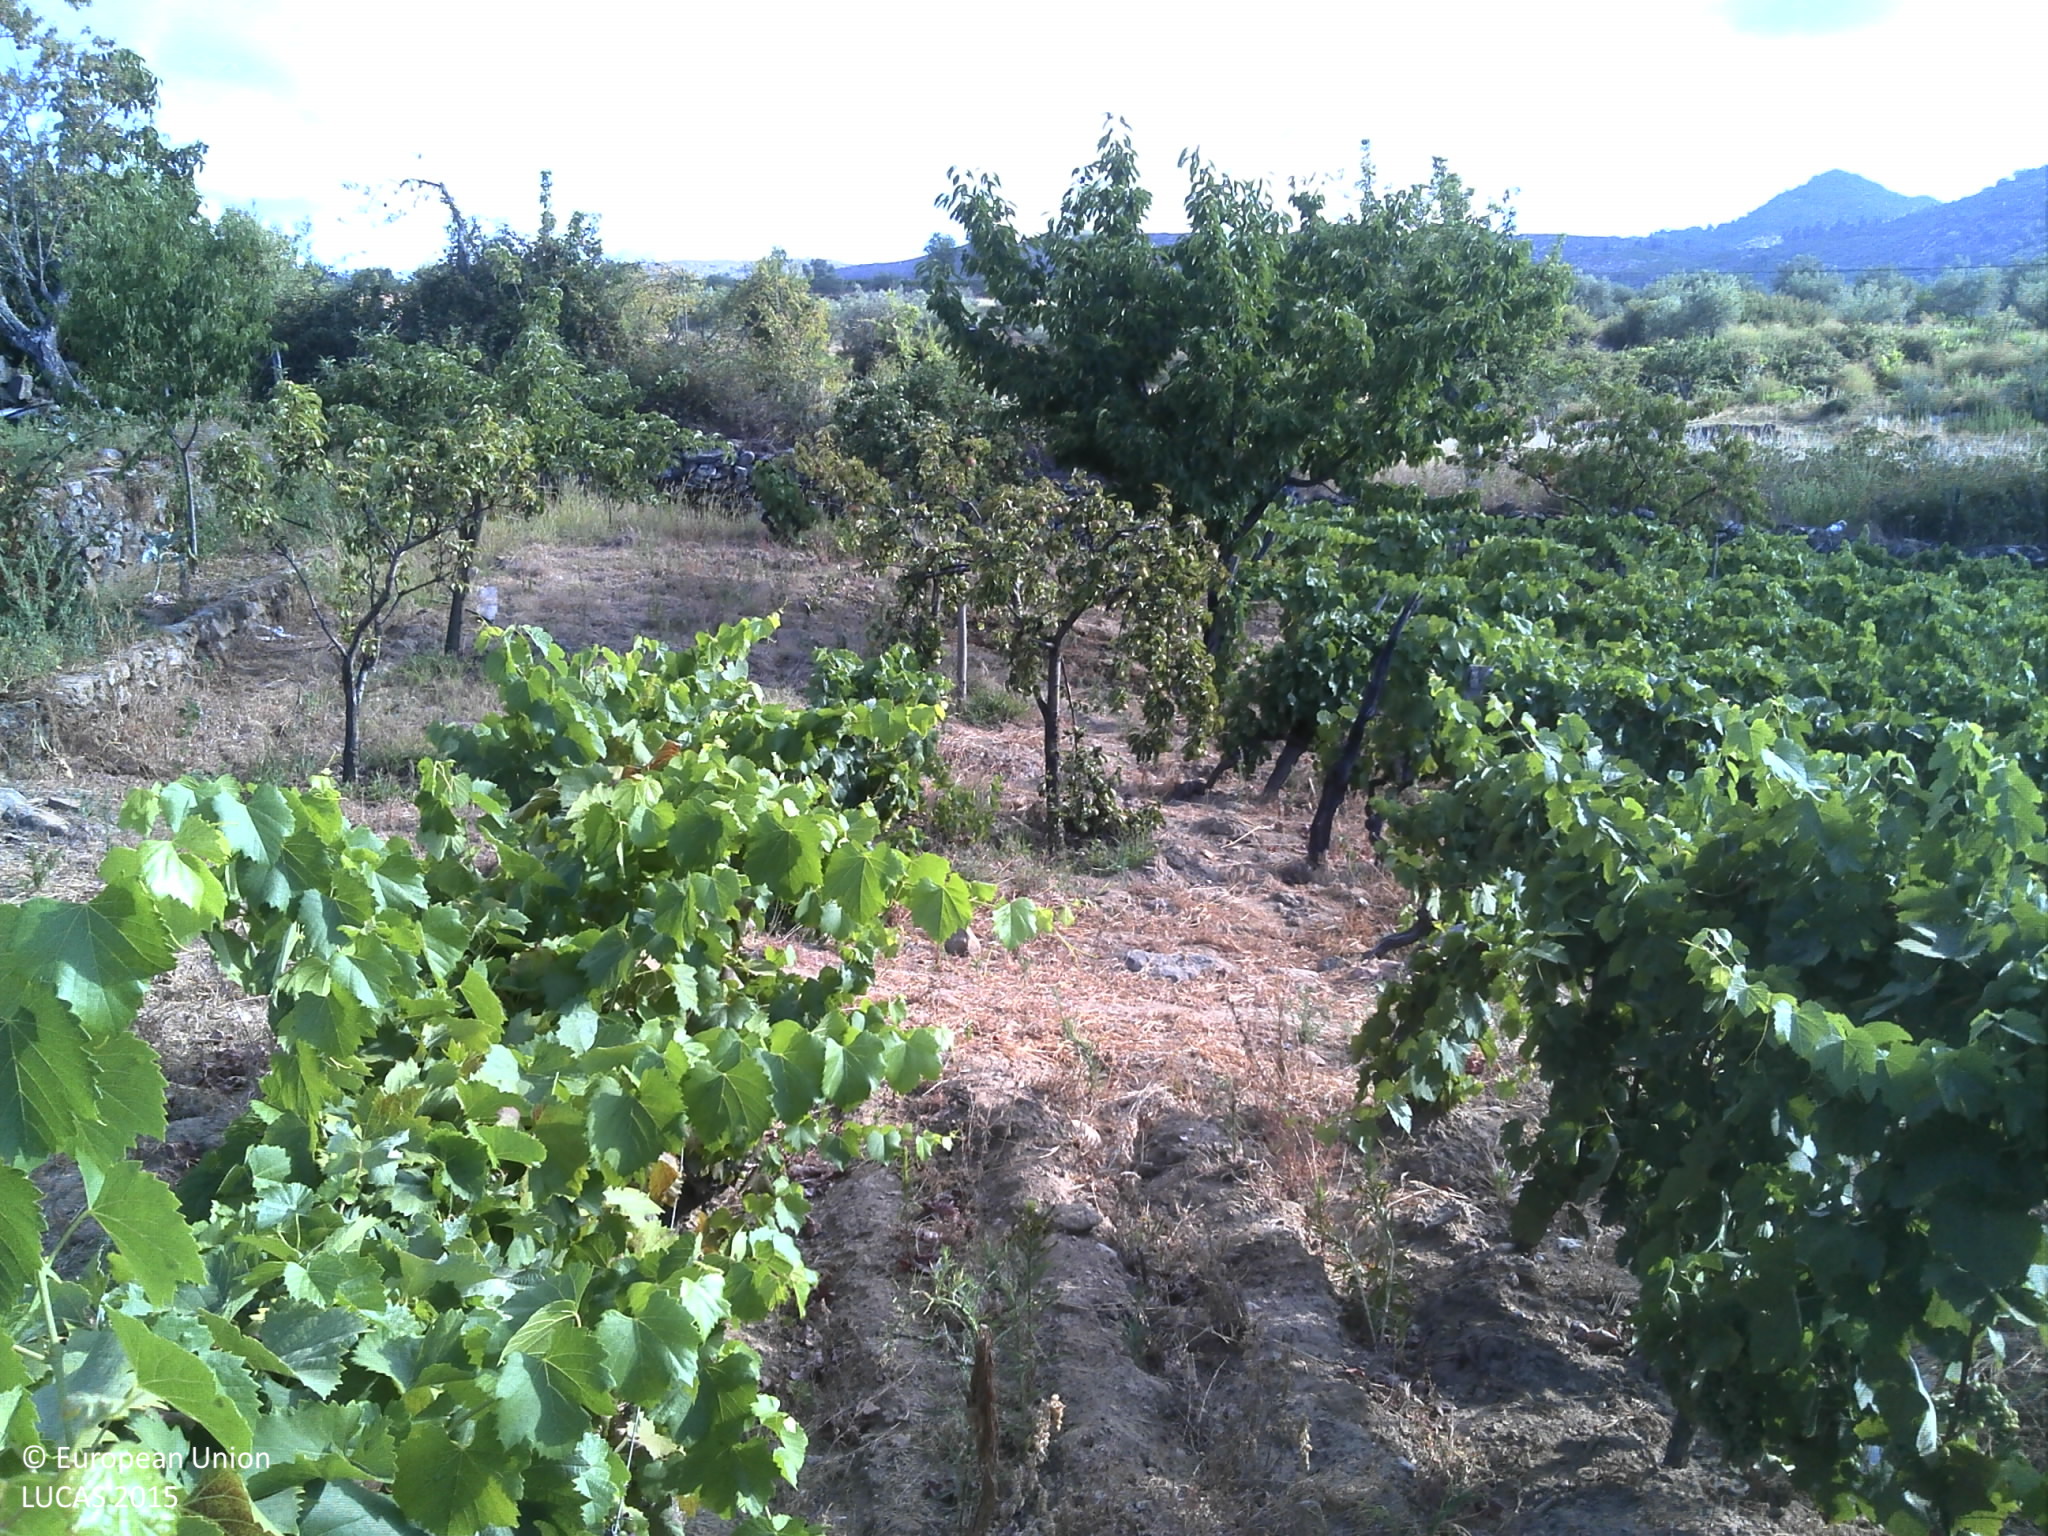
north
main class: Cropland
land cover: Vineyards
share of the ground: < 10 %
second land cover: Grassland without tree/shrub cover
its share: 50 - 75 %
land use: Agriculture (excluding fallow land and kitchen gardens)
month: July
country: PT
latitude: 41.2563
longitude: -7.4393
